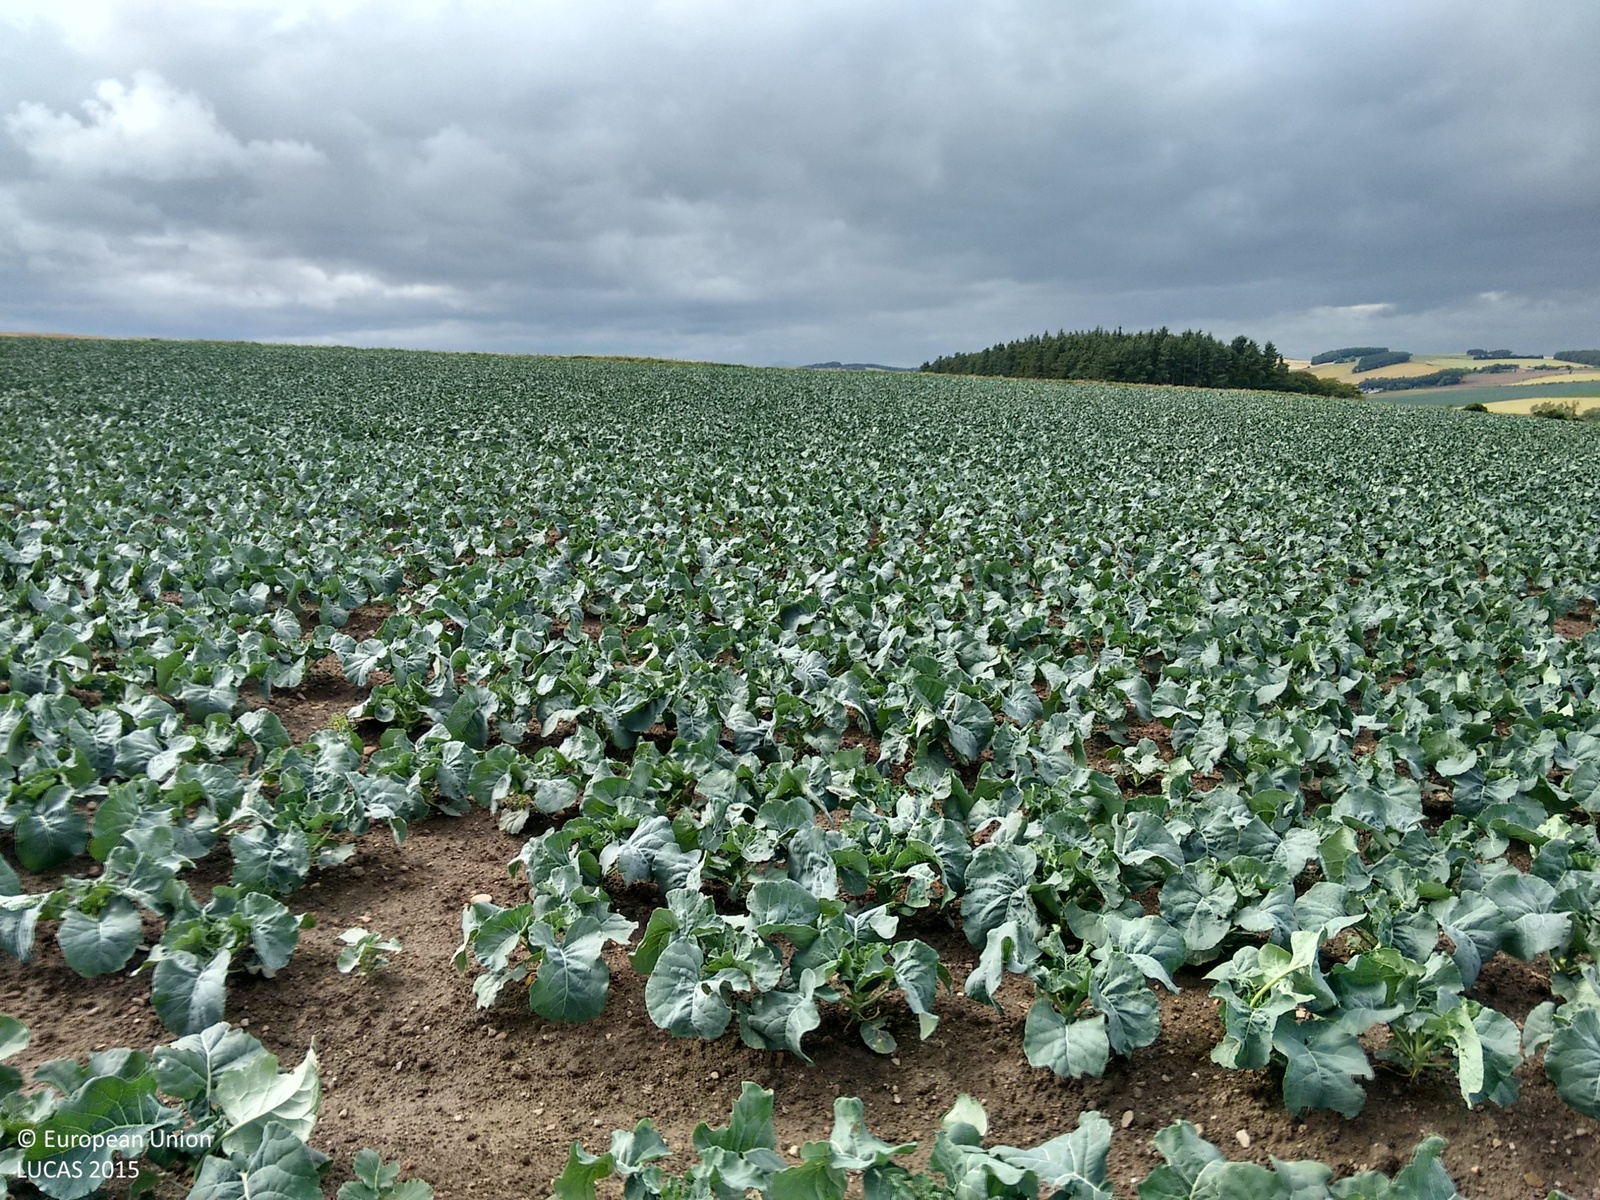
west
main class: Cropland
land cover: Other fresh vegetables
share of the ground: > 75 %
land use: Agriculture (excluding fallow land and kitchen gardens)
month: August
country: GB
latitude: 56.2946
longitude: -2.9436
